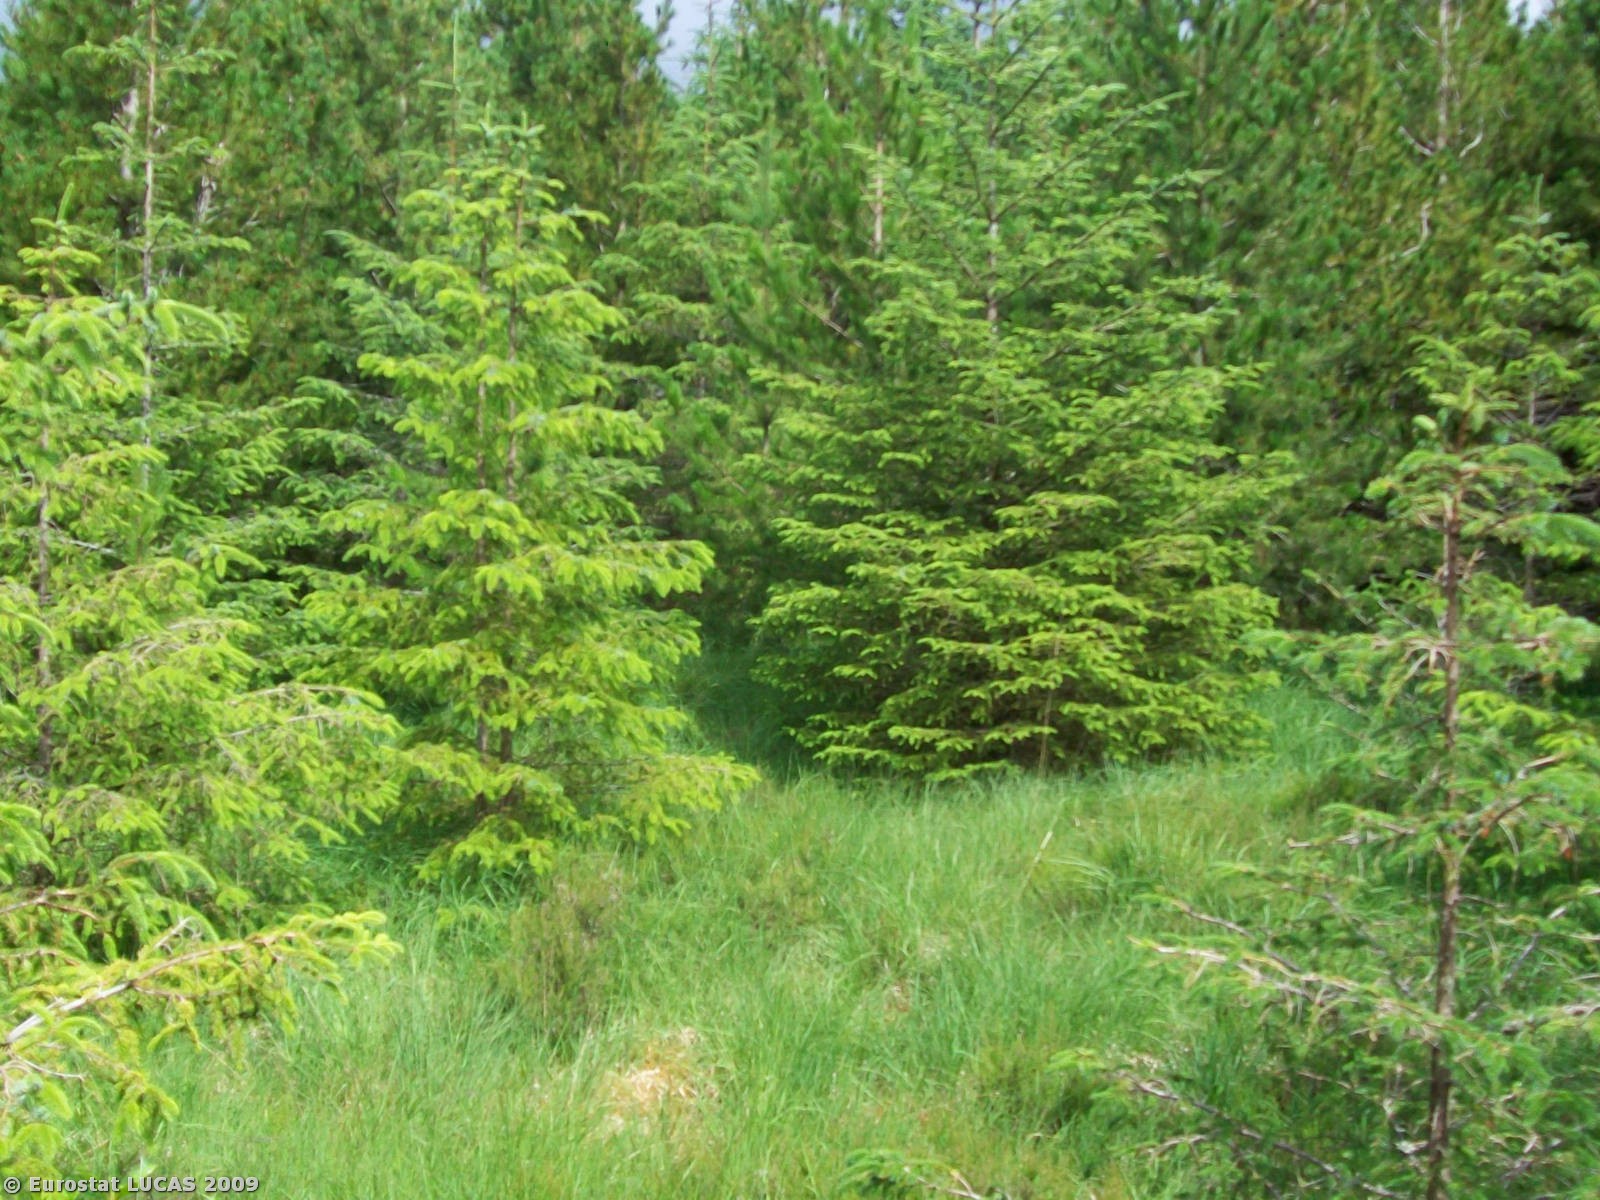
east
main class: Woodland
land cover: Coniferous woodland
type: plantations and self-sown exotic forest
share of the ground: > 75 %
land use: Forestry
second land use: Nature reserves
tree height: > 5 m
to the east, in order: Coniferous woodland; Ditches and canals; Coniferous woodland
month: July
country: IE
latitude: 54.0814
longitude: -9.7942
